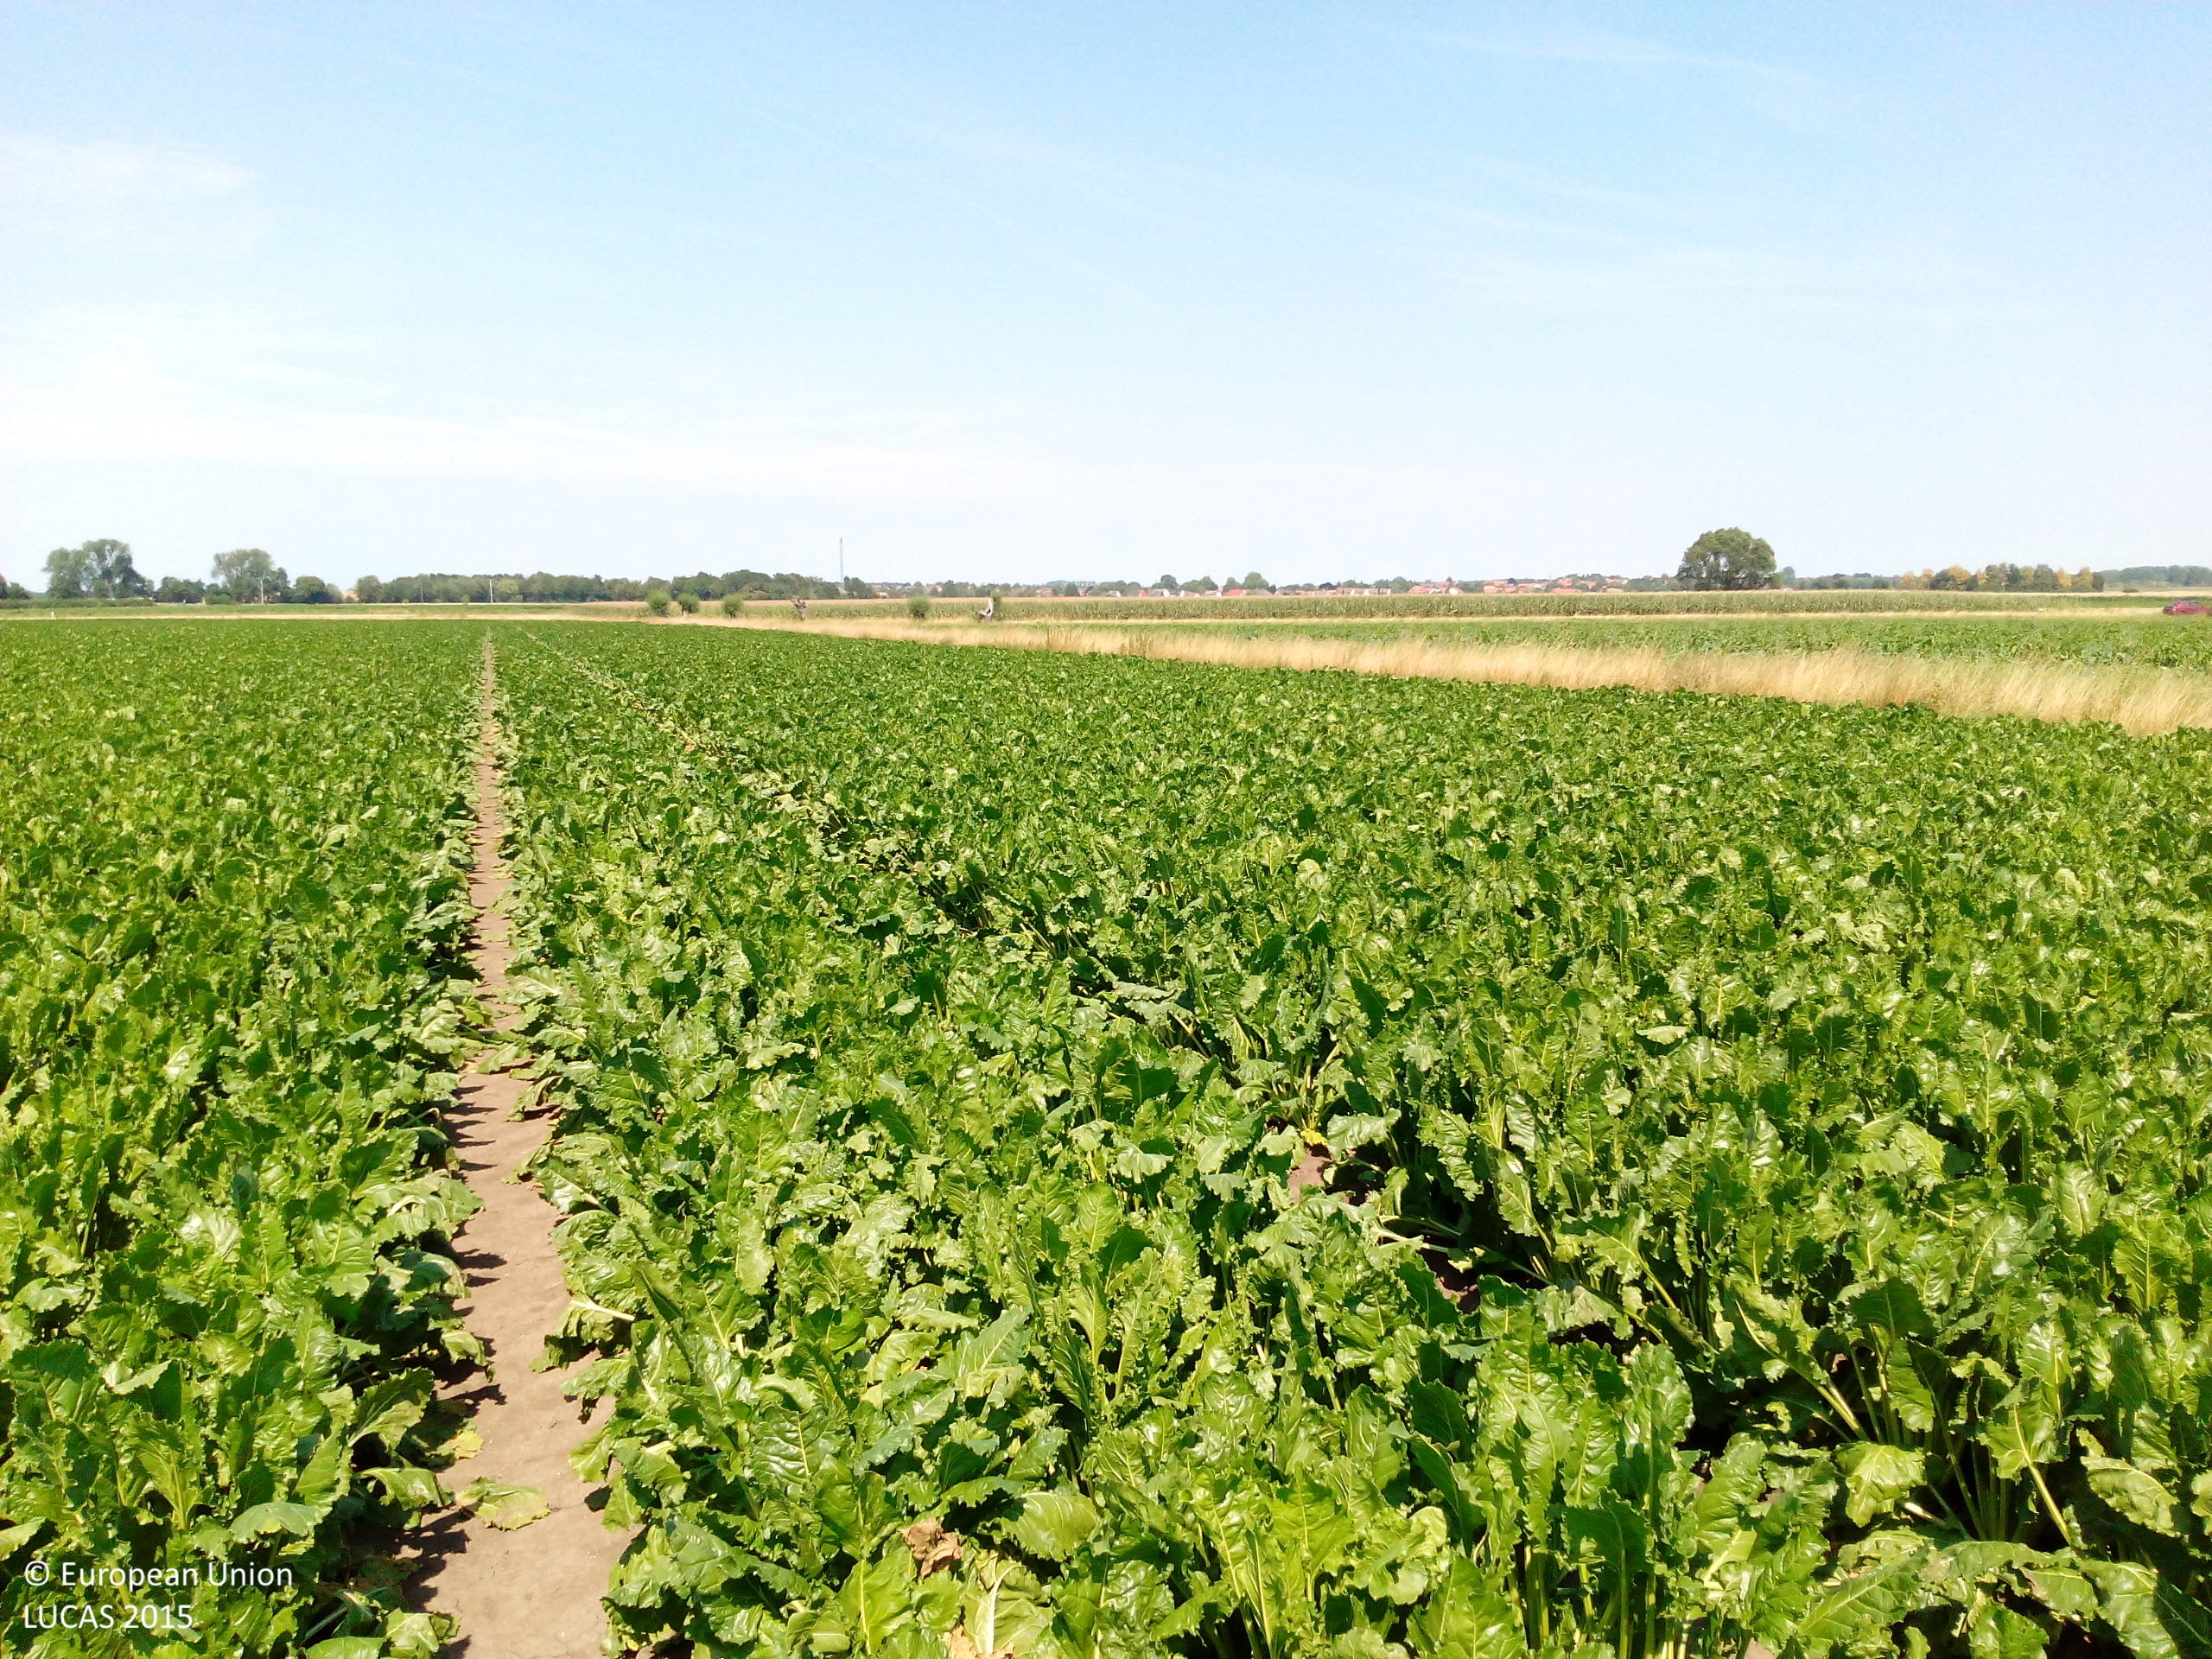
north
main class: Cropland
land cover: Sugar beet
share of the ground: > 75 %
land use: Agriculture (excluding fallow land and kitchen gardens)
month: August
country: DE
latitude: 52.1960
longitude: 10.6289
